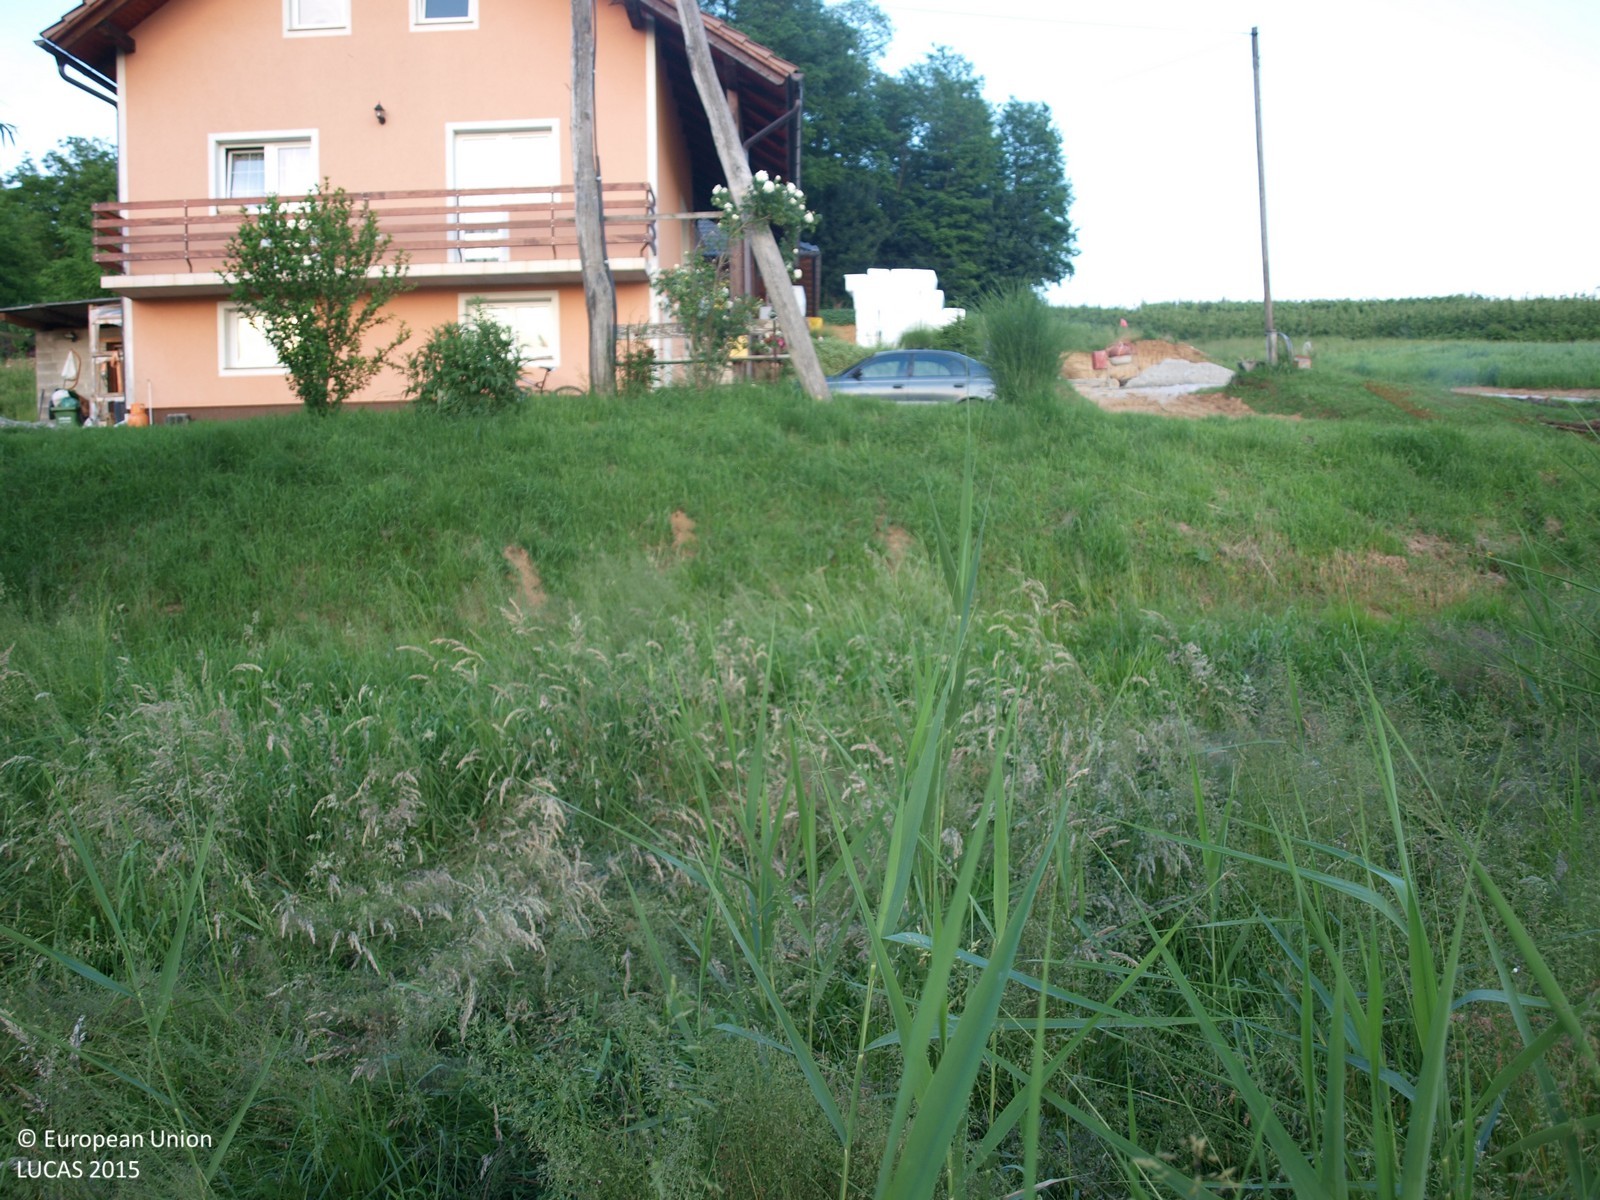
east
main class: Grassland
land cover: Grassland without tree/shrub cover
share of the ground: > 75 %
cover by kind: herbaceous plants 100 %
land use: Residential
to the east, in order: Grassland without tree/shrub cover; Artificial constructions in urban areas; Broadleaved woodland; Apple fruit; Spontaneously vegetated surfaces; Cherry fruit; Conifer hedges; Grass margins; Paved roads, cycling and walking lanes; Grass margins; Fences; Cherry fruit; Spontaneously vegetated surfaces; Rye; Grassland without tree/shrub cover; Maize; Spontaneously vegetated surfaces; Nuts trees; Other fresh vegetables
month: June
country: HR
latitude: 46.3027
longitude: 16.1147
